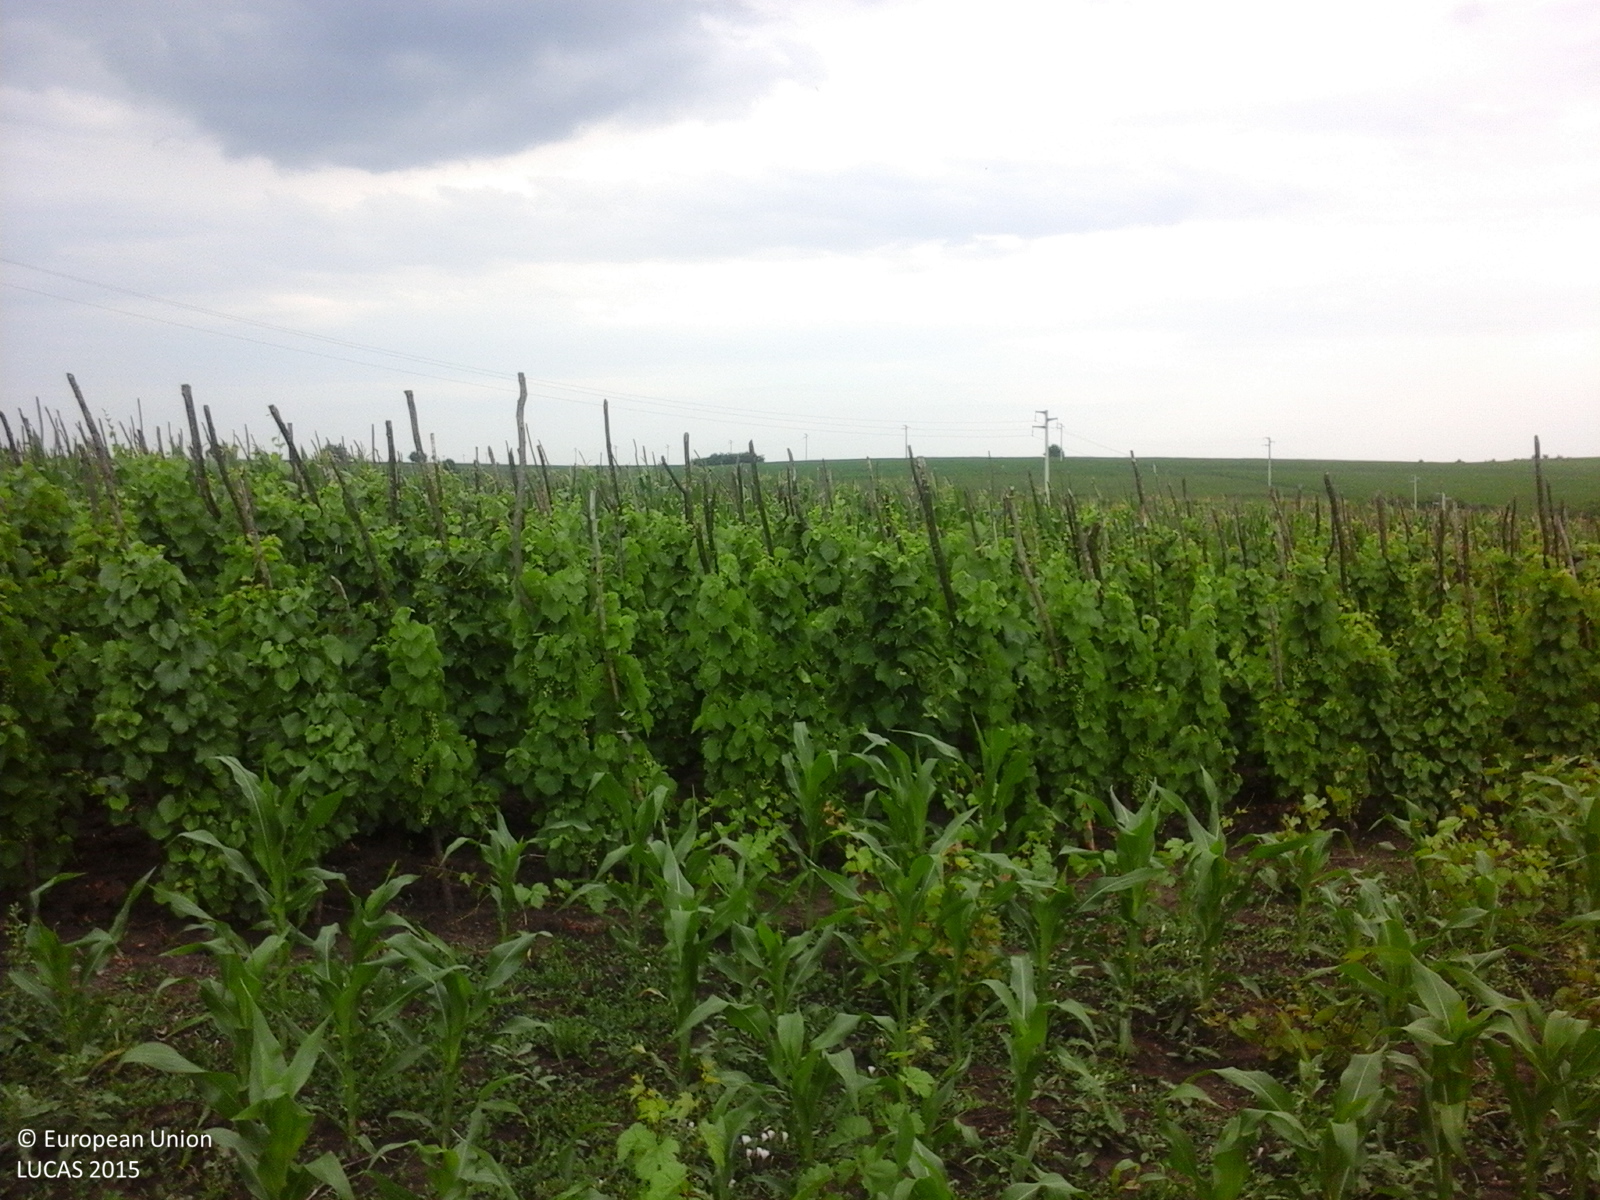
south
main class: Cropland
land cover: Vineyards
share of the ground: 10 - 25 %
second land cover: Maize
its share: 50 - 75 %
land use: Agriculture (excluding fallow land and kitchen gardens)
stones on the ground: < 10 %
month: June
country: RO
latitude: 44.1244
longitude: 26.1364
